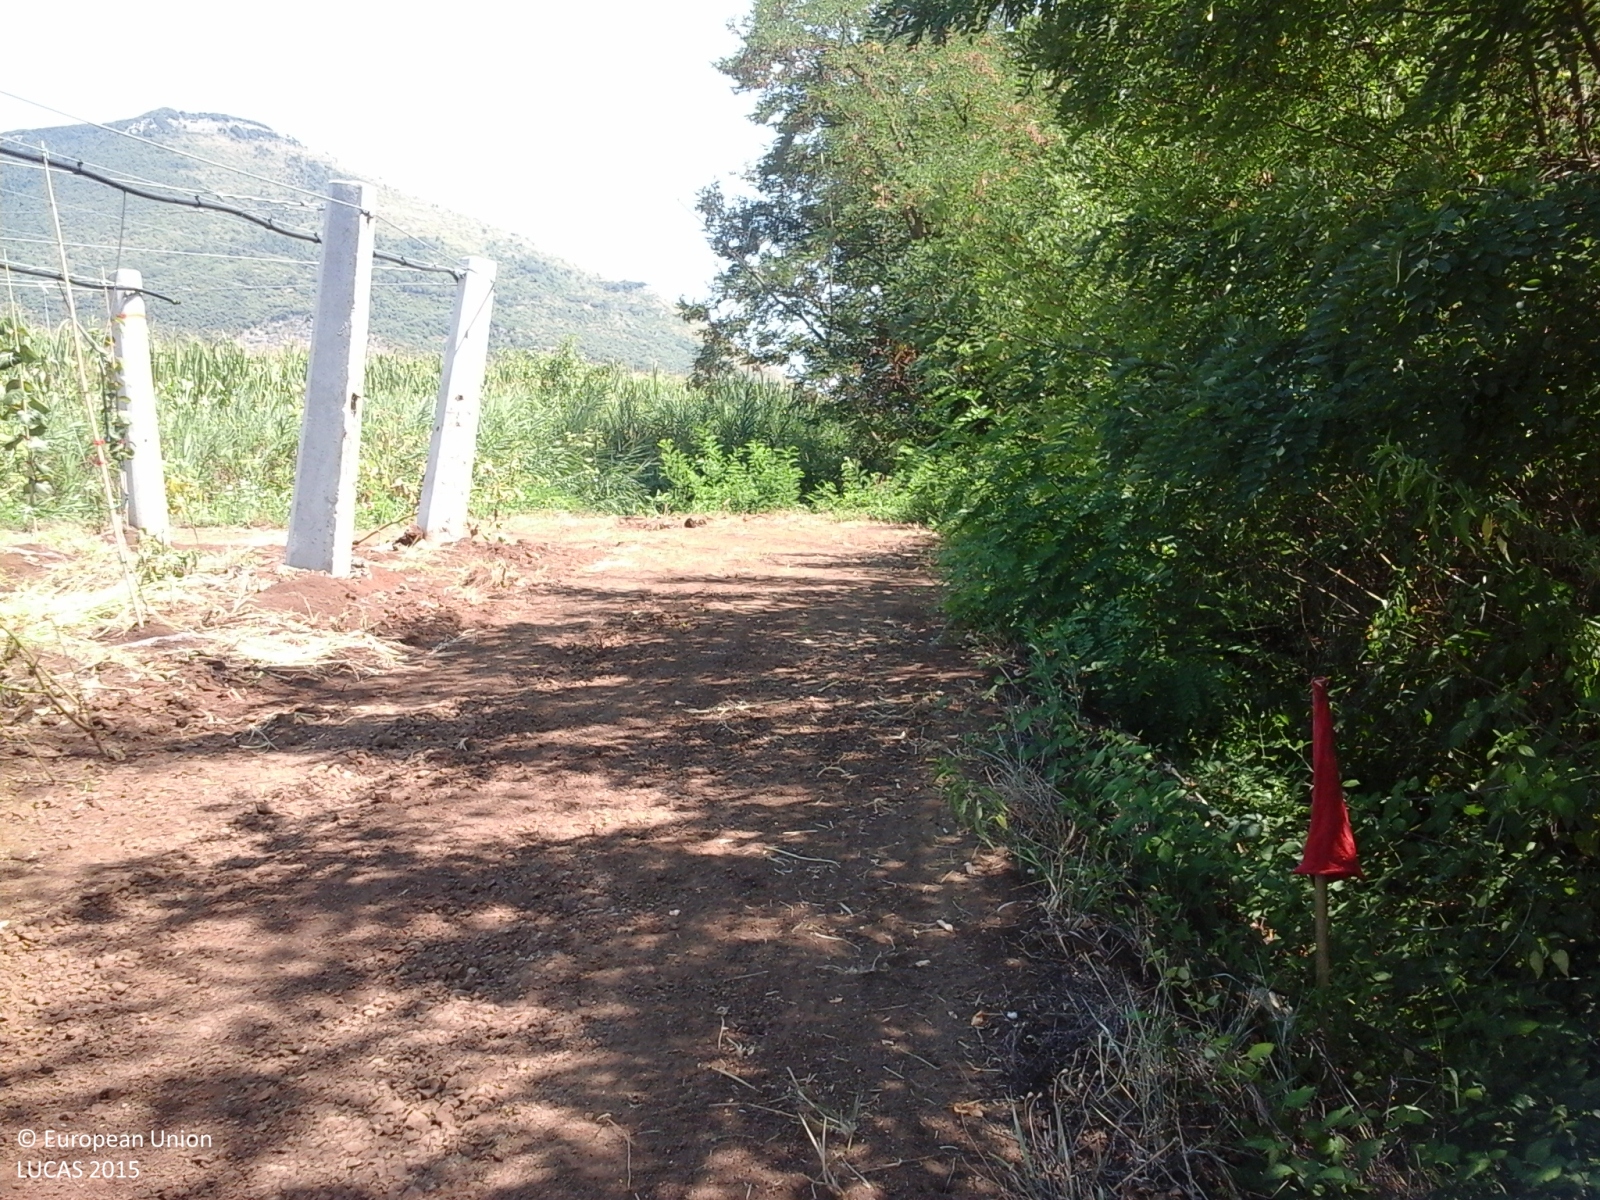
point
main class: Cropland
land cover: Other fruit trees and berries
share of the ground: 50 - 75 %
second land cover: Other bare soil
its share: > 75 %
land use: Agriculture (excluding fallow land and kitchen gardens)
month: July
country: IT
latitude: 41.5256
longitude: 12.9724
